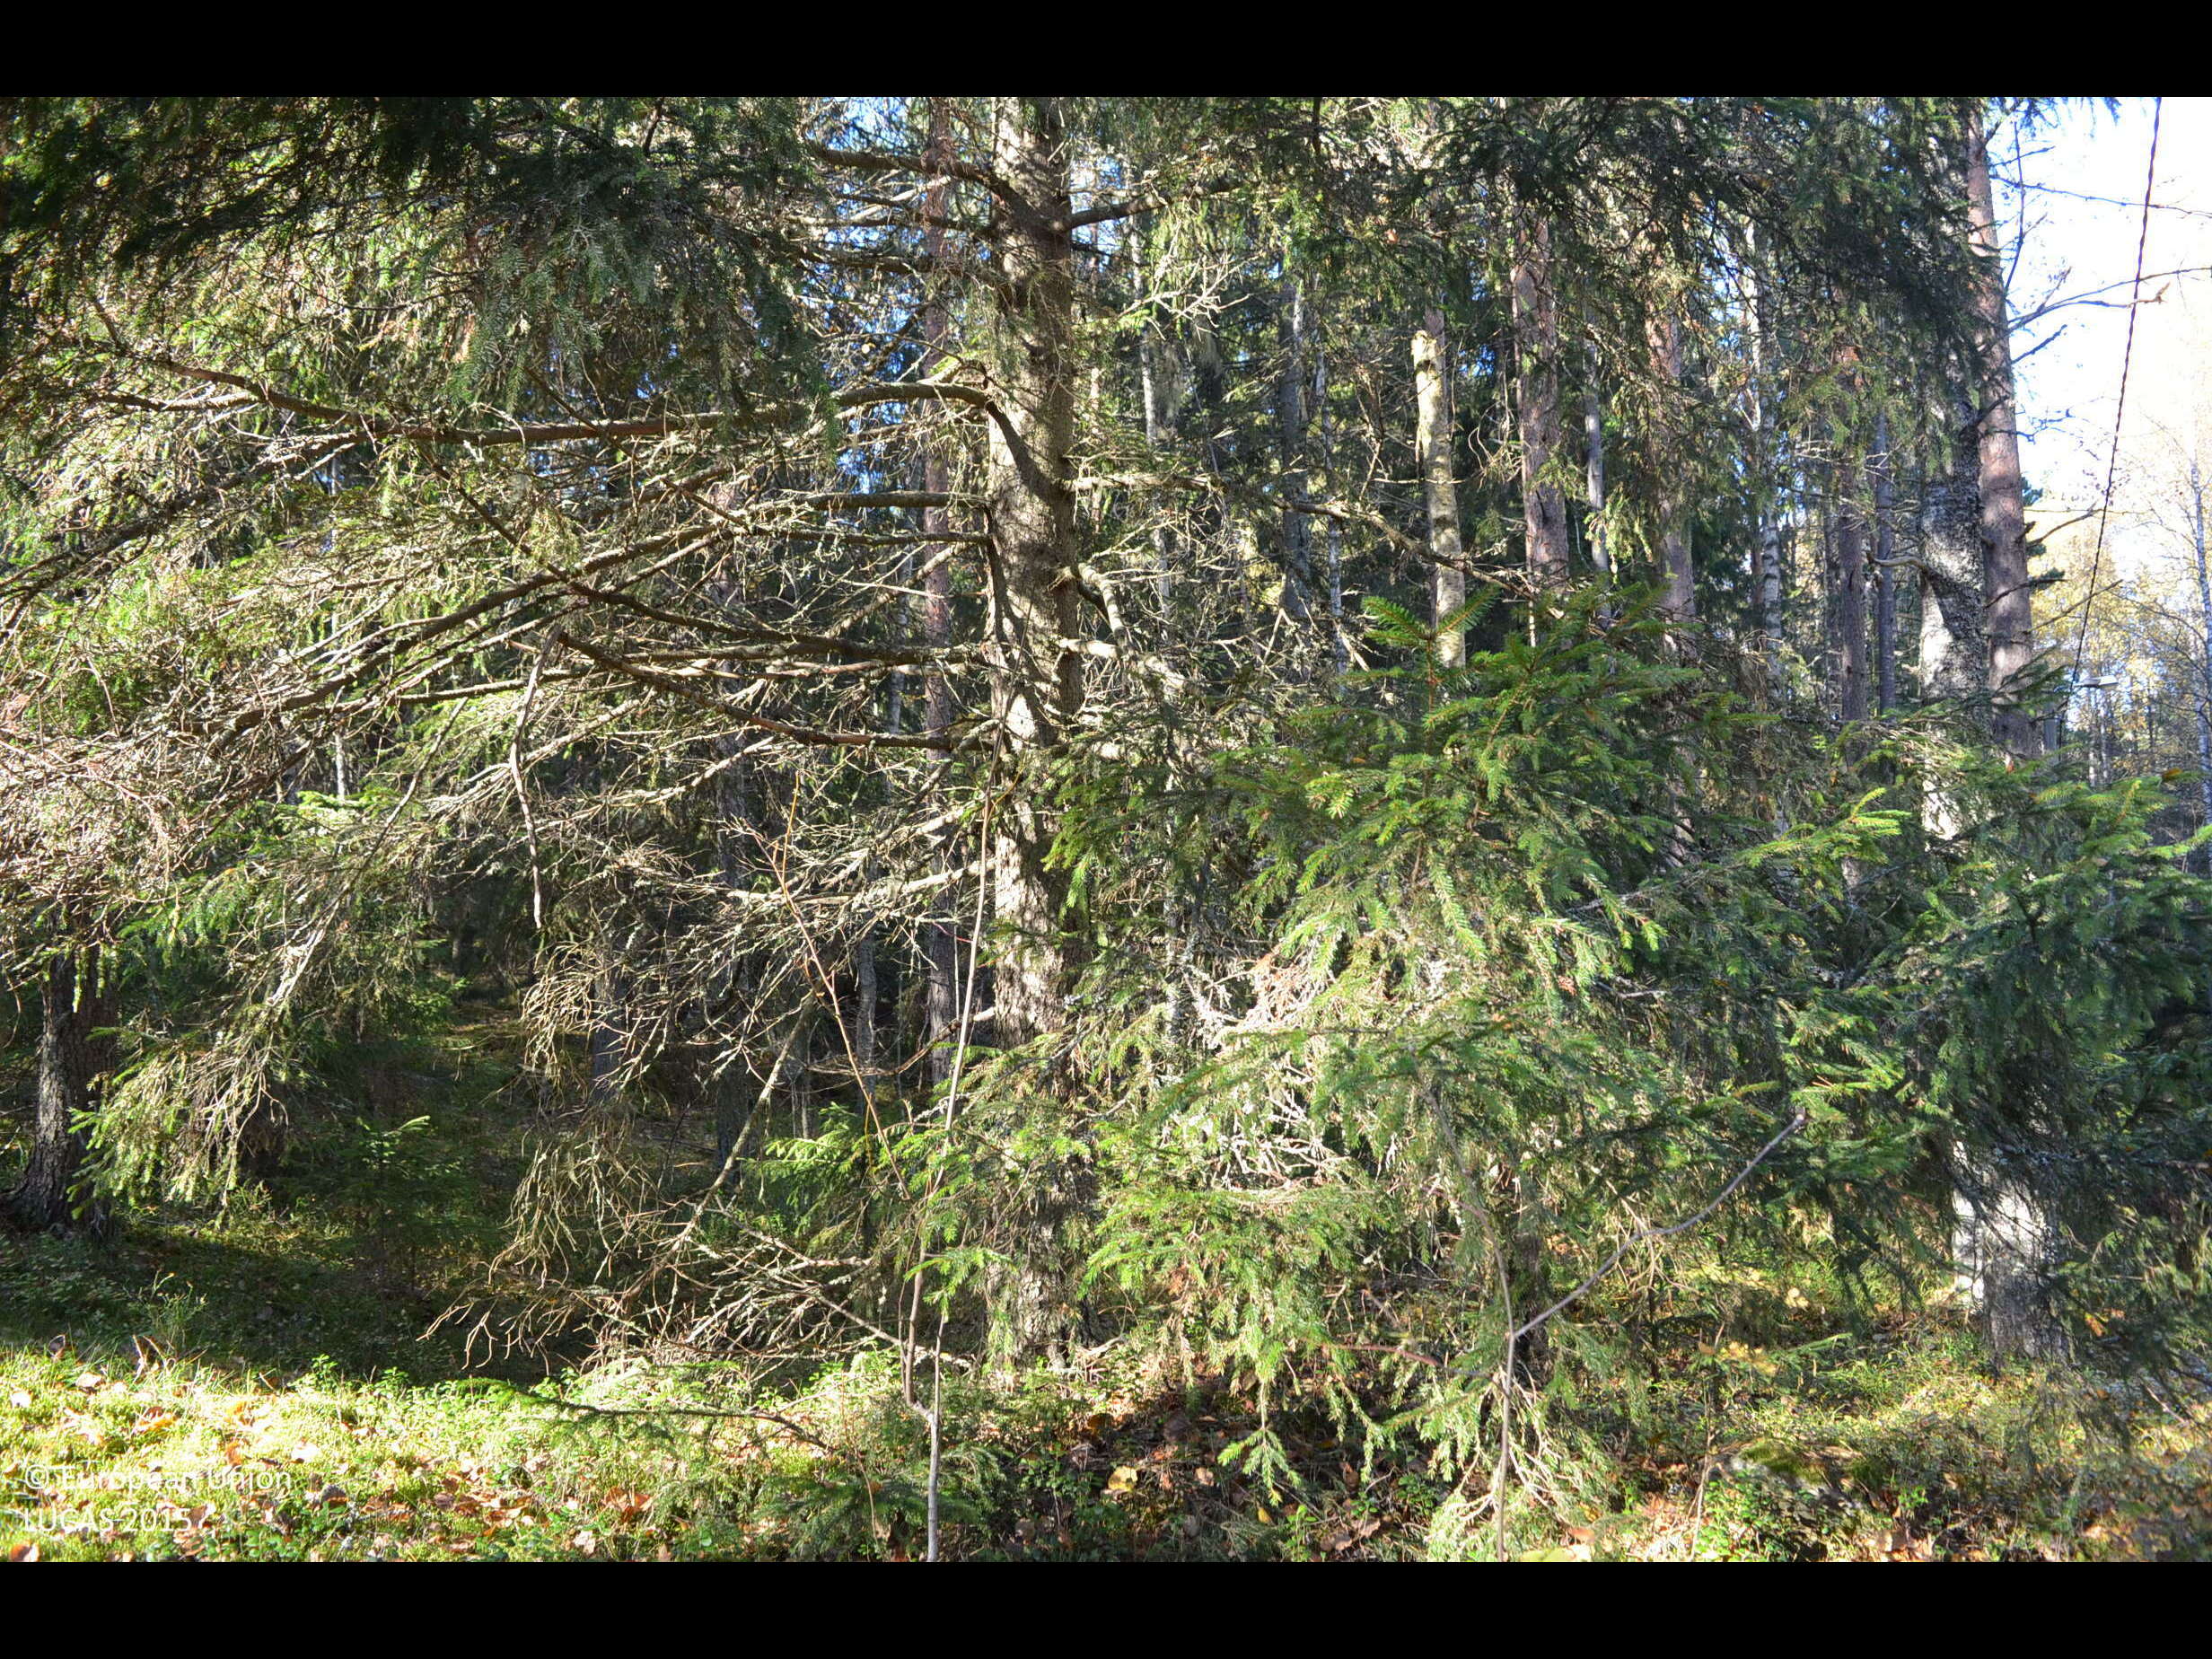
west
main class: Woodland
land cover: Other mixed woodland
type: boreal forest
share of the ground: 50 - 75 %
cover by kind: coniferous forest trees 40 %, broadleaved forest trees 30 %, shrubs 15 %, lichens and mosses 10 %
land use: Amenities, museums, leisure
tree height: > 5 m
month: October
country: FI
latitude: 61.5118
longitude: 23.8234
